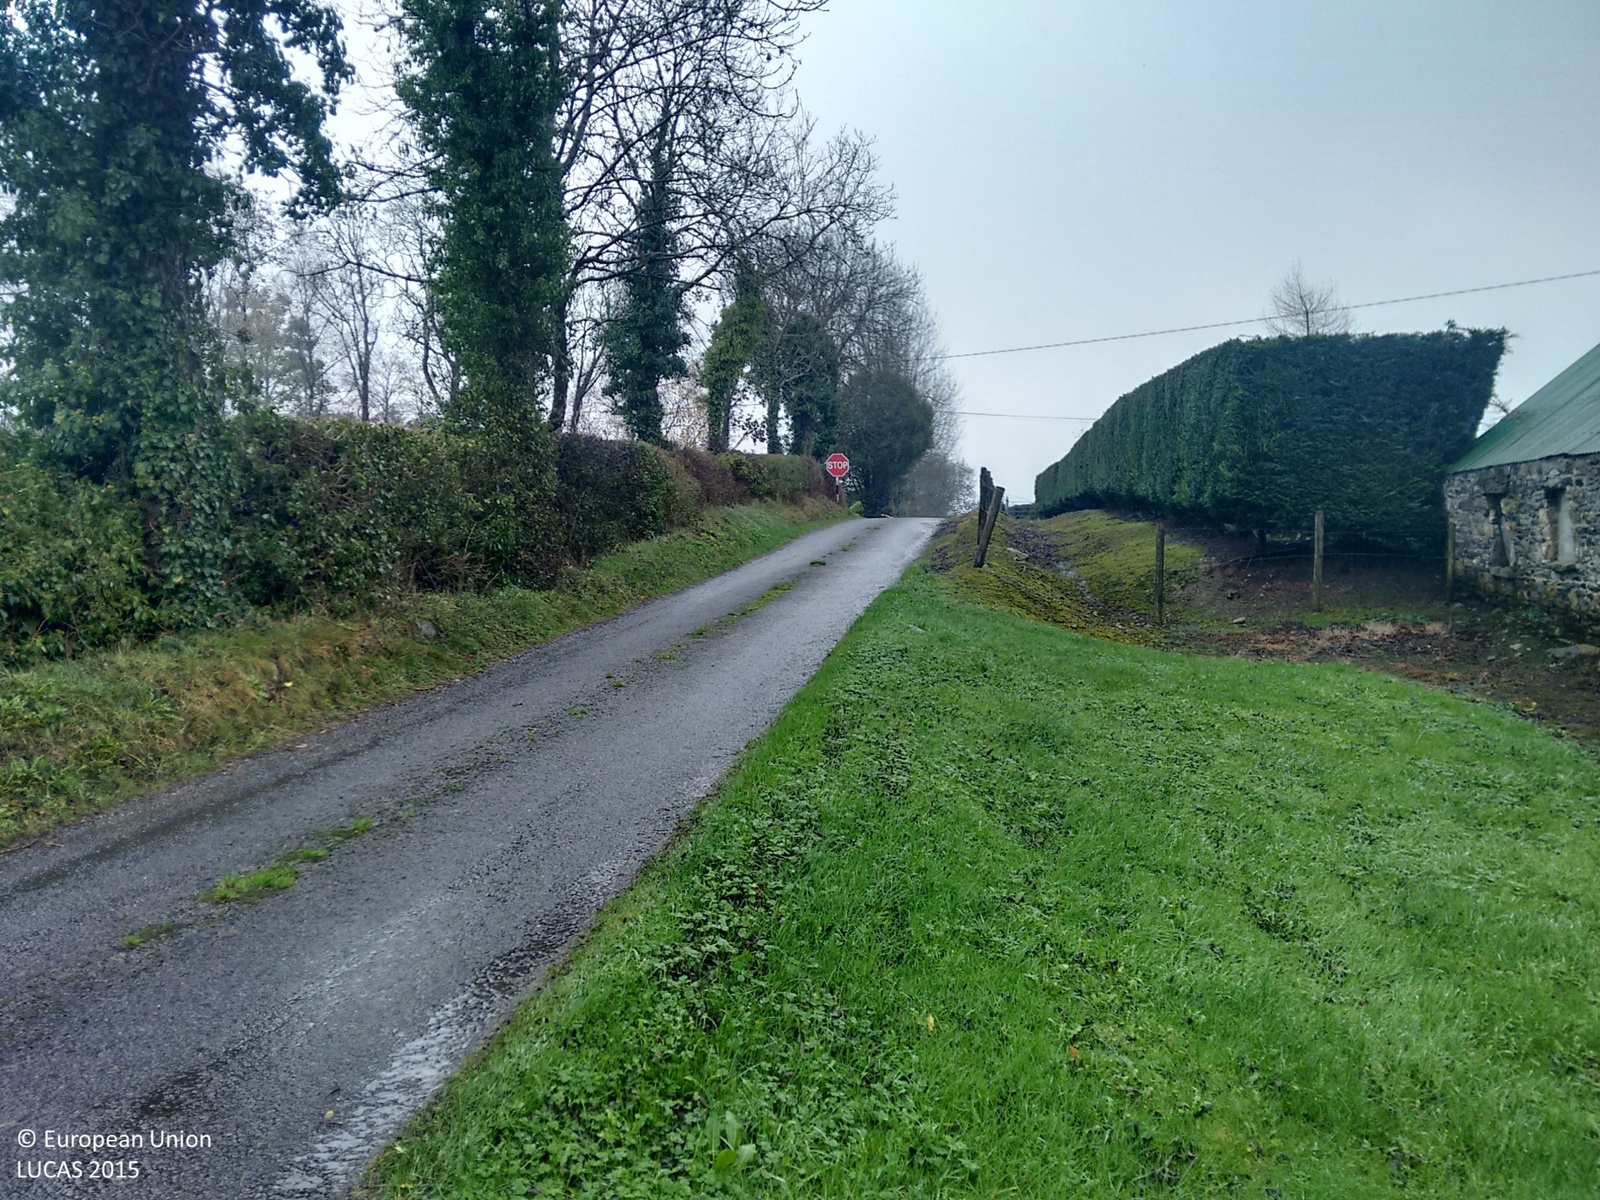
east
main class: Grassland
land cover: Grassland without tree/shrub cover
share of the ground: > 75 %
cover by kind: herbaceous plants 100 %
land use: Agriculture (excluding fallow land and kitchen gardens)
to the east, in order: Grassland without tree/shrub cover; Artificial constructions in urban areas; Abandoned hedges; Grassland without tree/shrub cover; Fences; Abandoned hedges; Grassland with sparse tree/shrub cover; Abandoned hedges; Grassland without tree/shrub cover; Fences; Grassland without tree/shrub cover
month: November
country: IE
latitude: 53.9232
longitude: -7.8483
